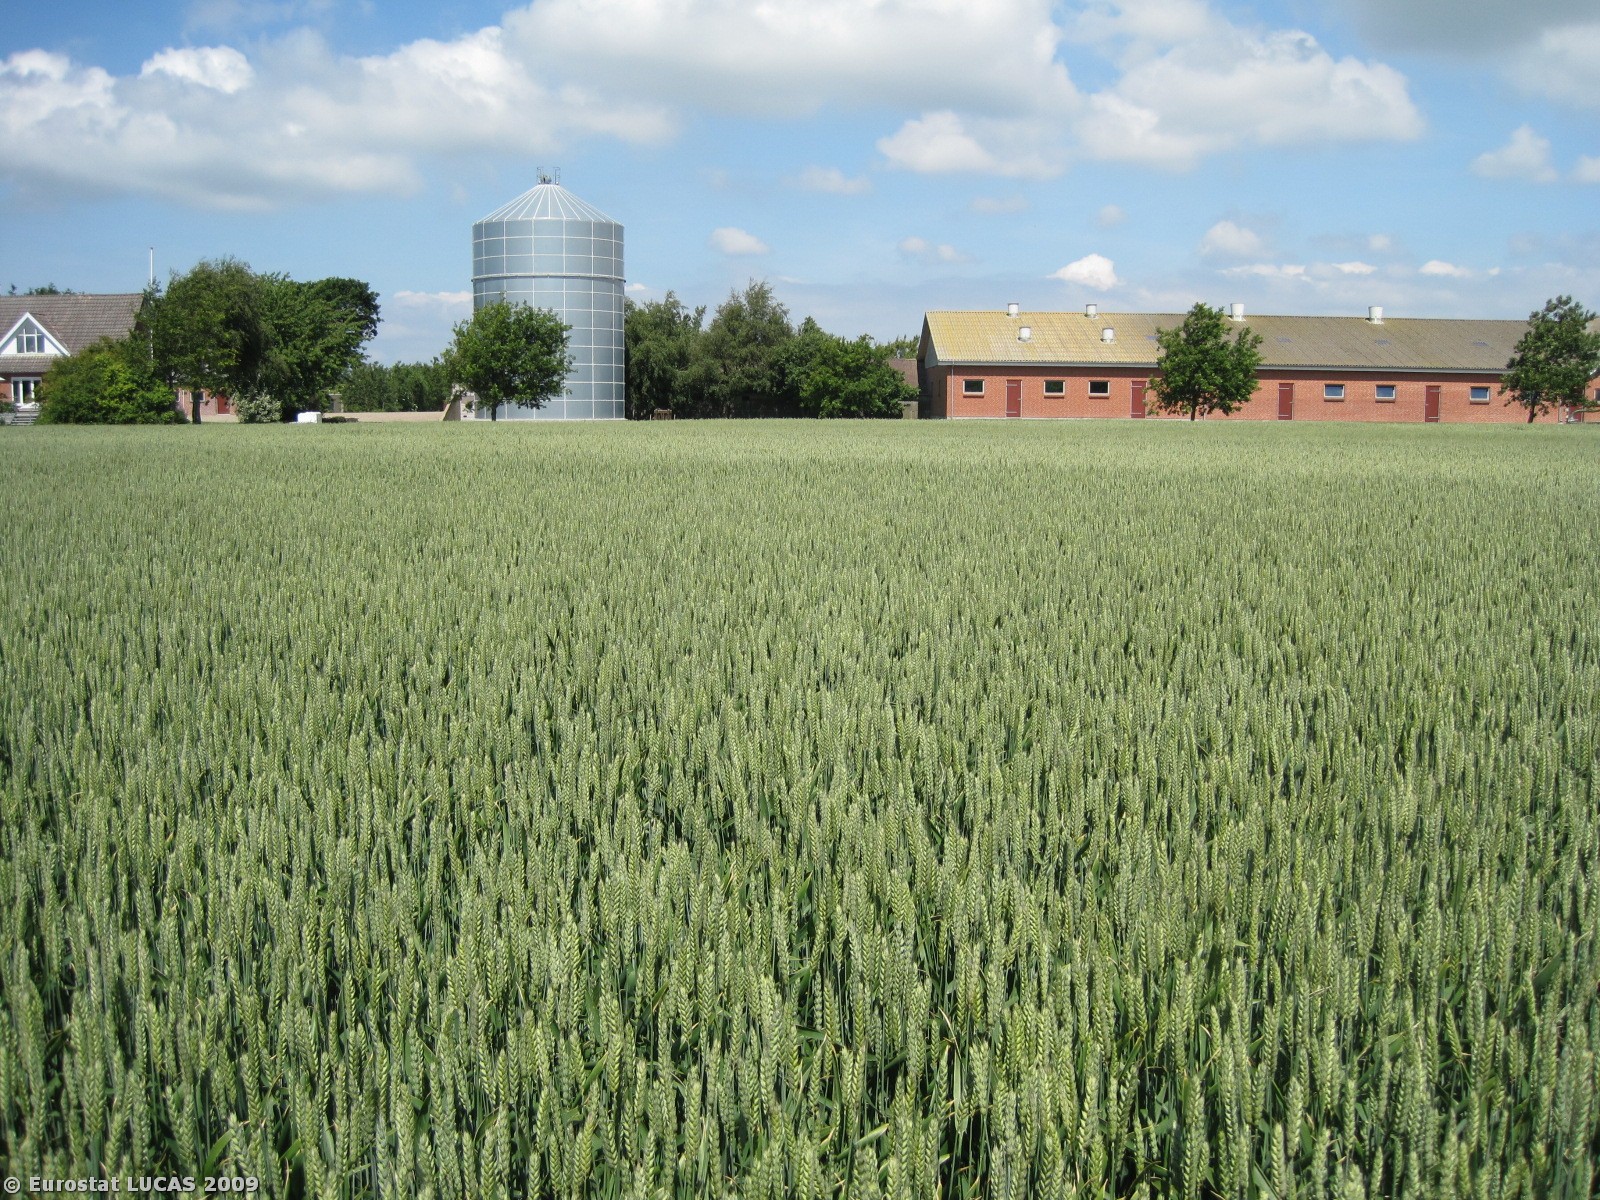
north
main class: Cropland
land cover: Common wheat
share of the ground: > 75 %
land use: Agriculture (excluding fallow land and kitchen gardens)
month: June
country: DK
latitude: 56.5415
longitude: 8.7818
